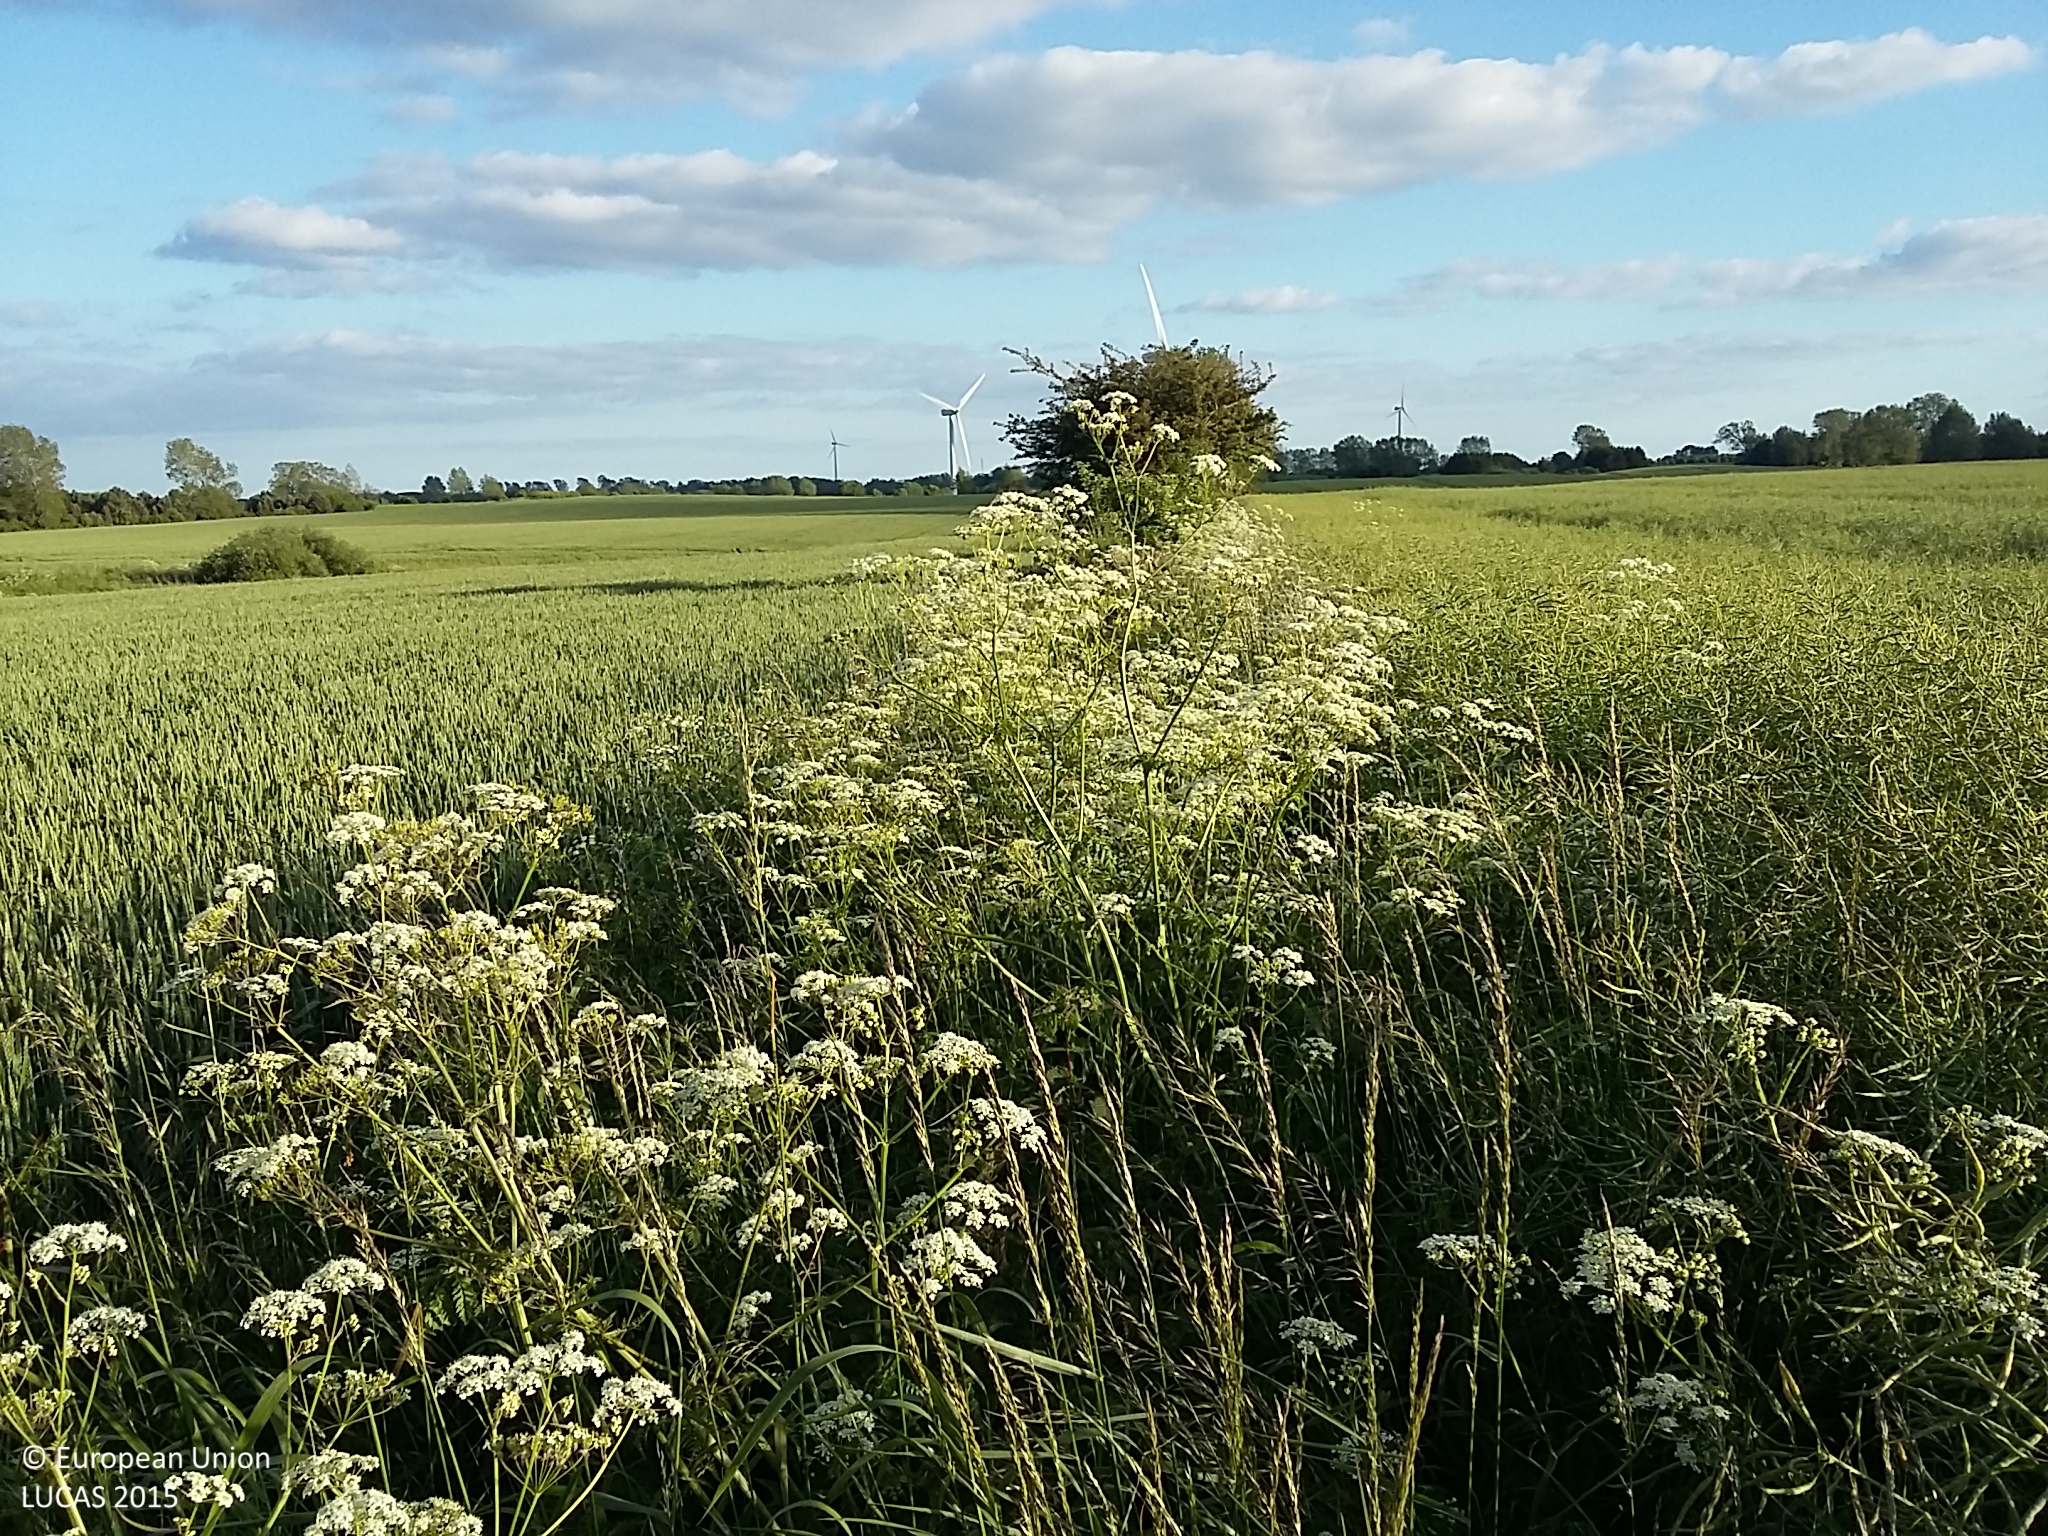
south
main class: Cropland
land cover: Rape and turnip rape
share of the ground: > 75 %
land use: Agriculture (excluding fallow land and kitchen gardens)
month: June
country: DK
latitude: 55.2150
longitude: 10.7381
